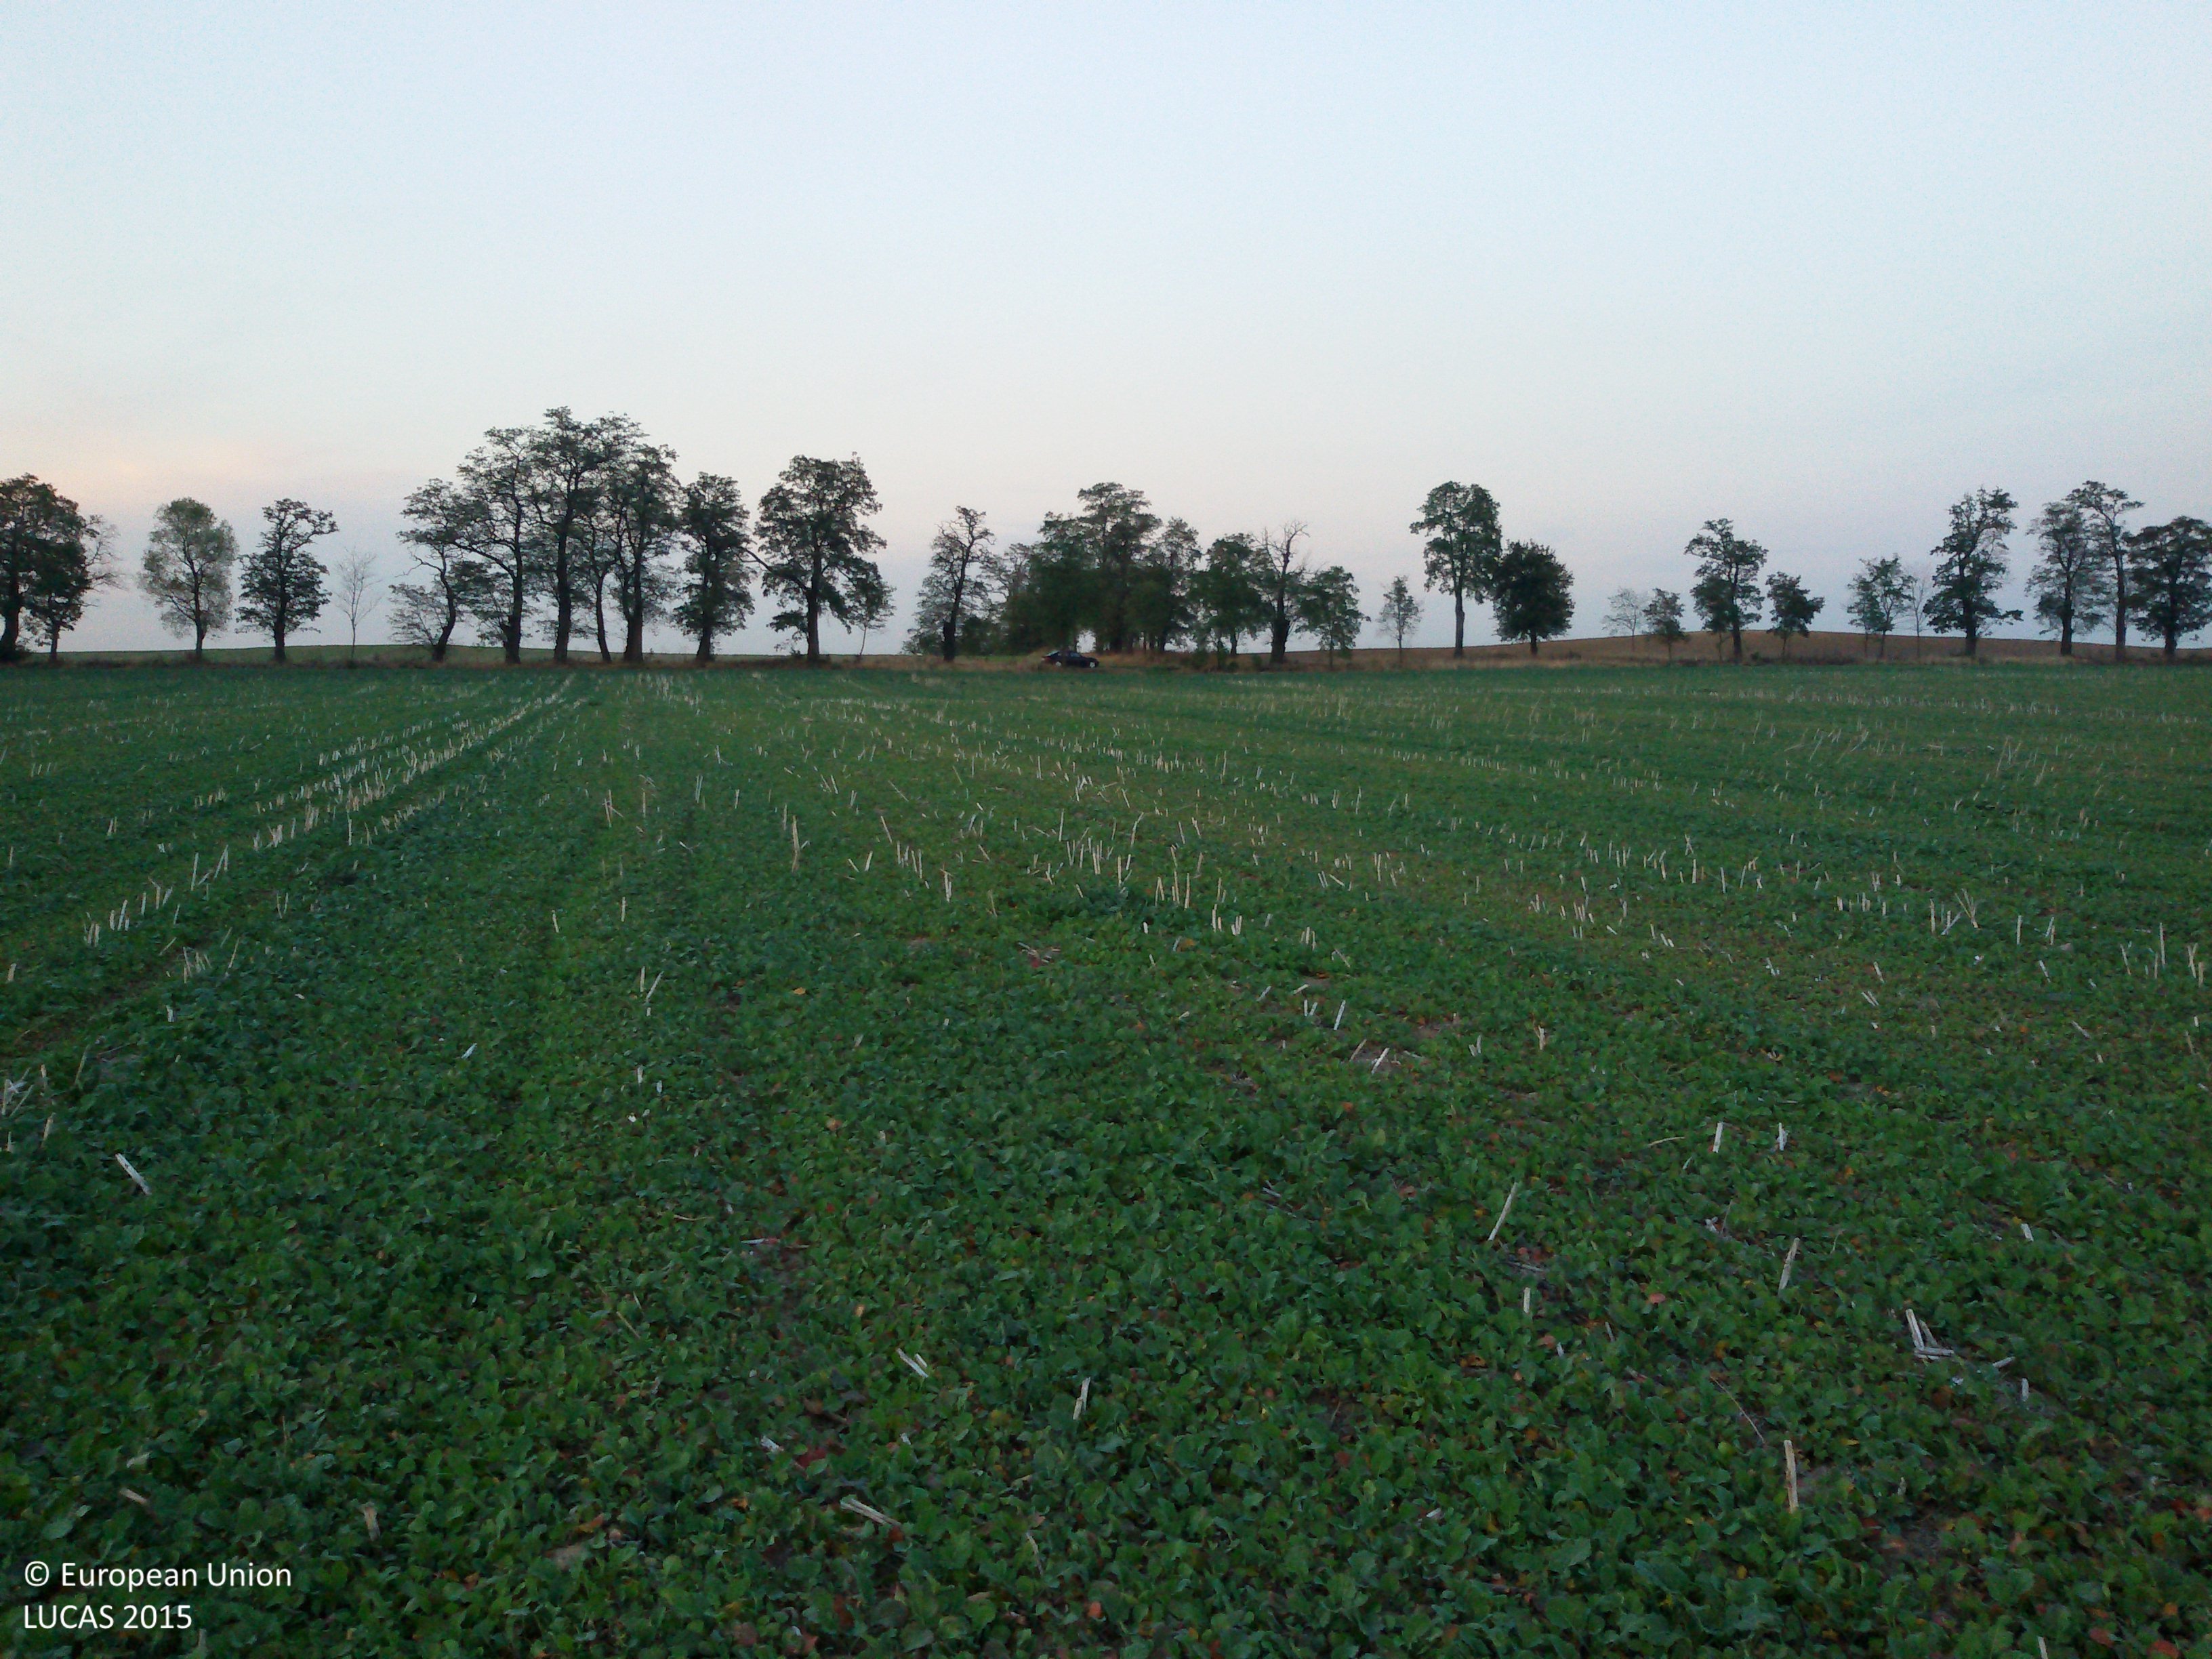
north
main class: Cropland
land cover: Rape and turnip rape
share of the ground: > 75 %
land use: Agriculture (excluding fallow land and kitchen gardens)
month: September
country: PL
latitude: 52.3609
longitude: 17.9892
